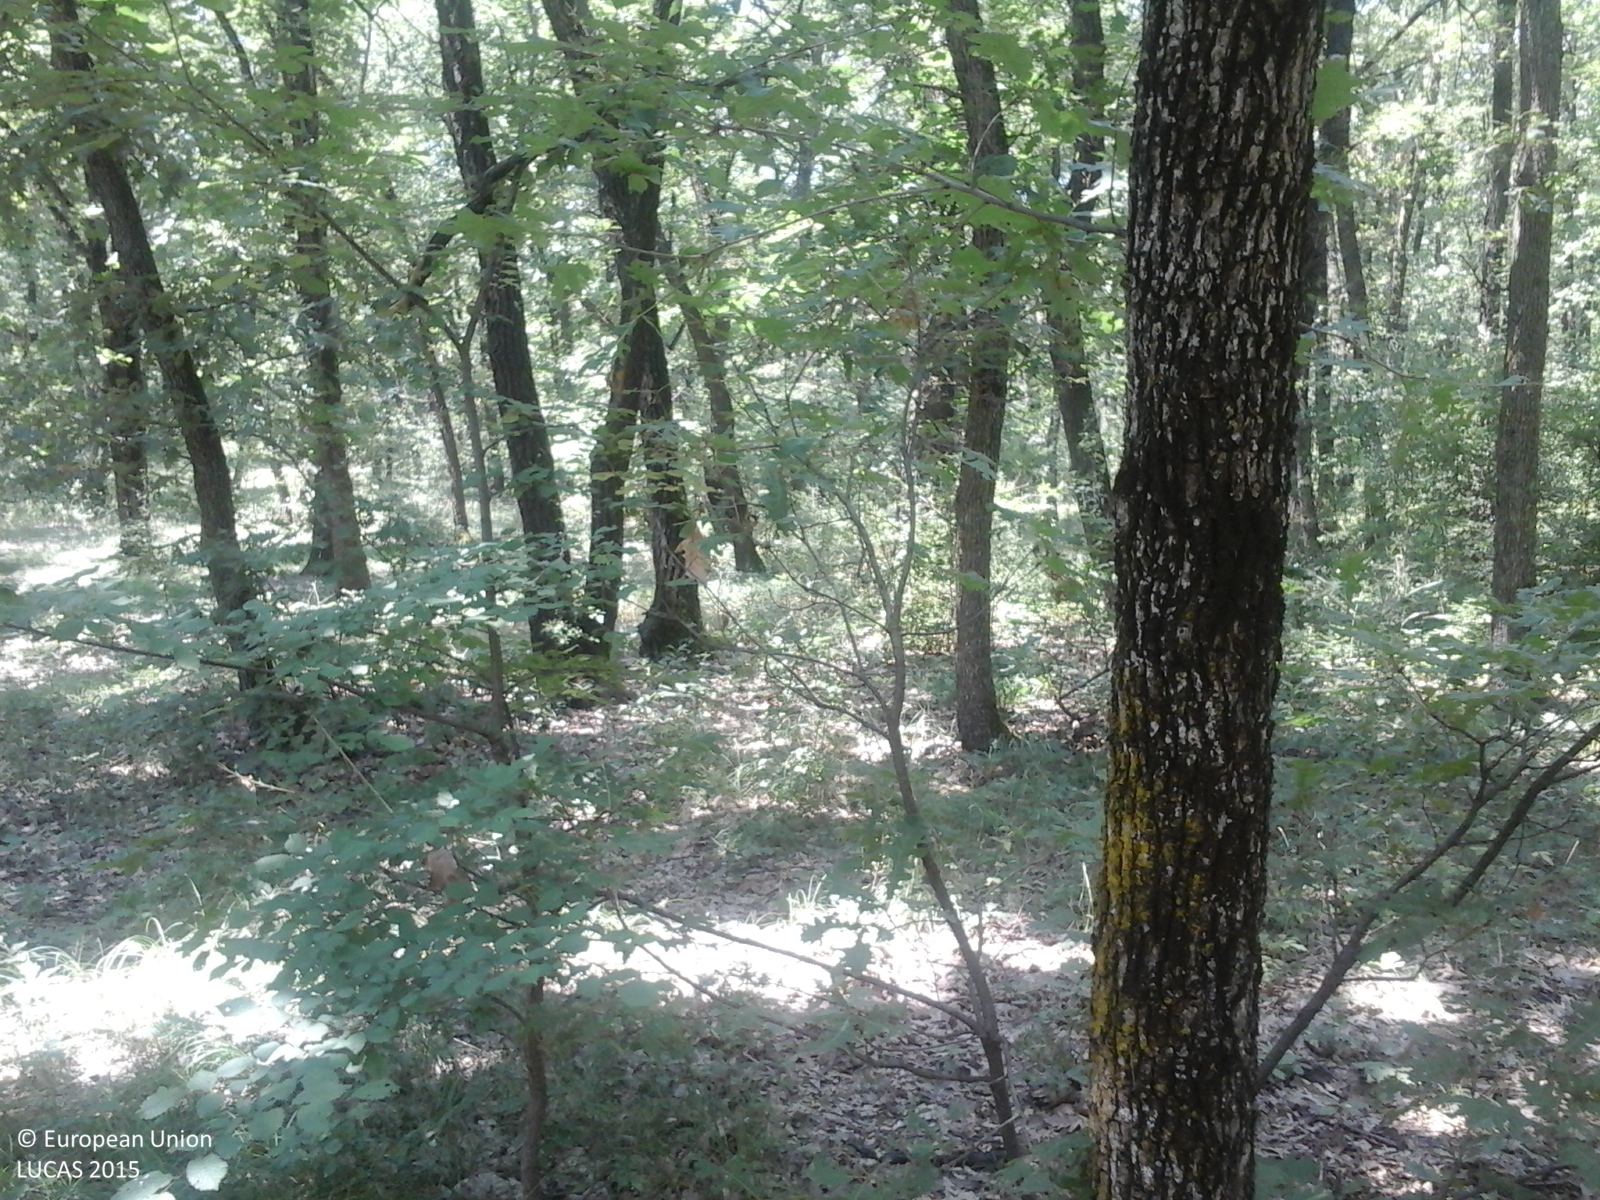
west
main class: Woodland
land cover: Broadleaved woodland
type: acidophilous oak and oak-birch forest
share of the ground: > 75 %
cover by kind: broadleaved forest trees 100 %
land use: Forestry
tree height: > 5 m
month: July
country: RO
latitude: 44.0764
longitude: 25.2539
